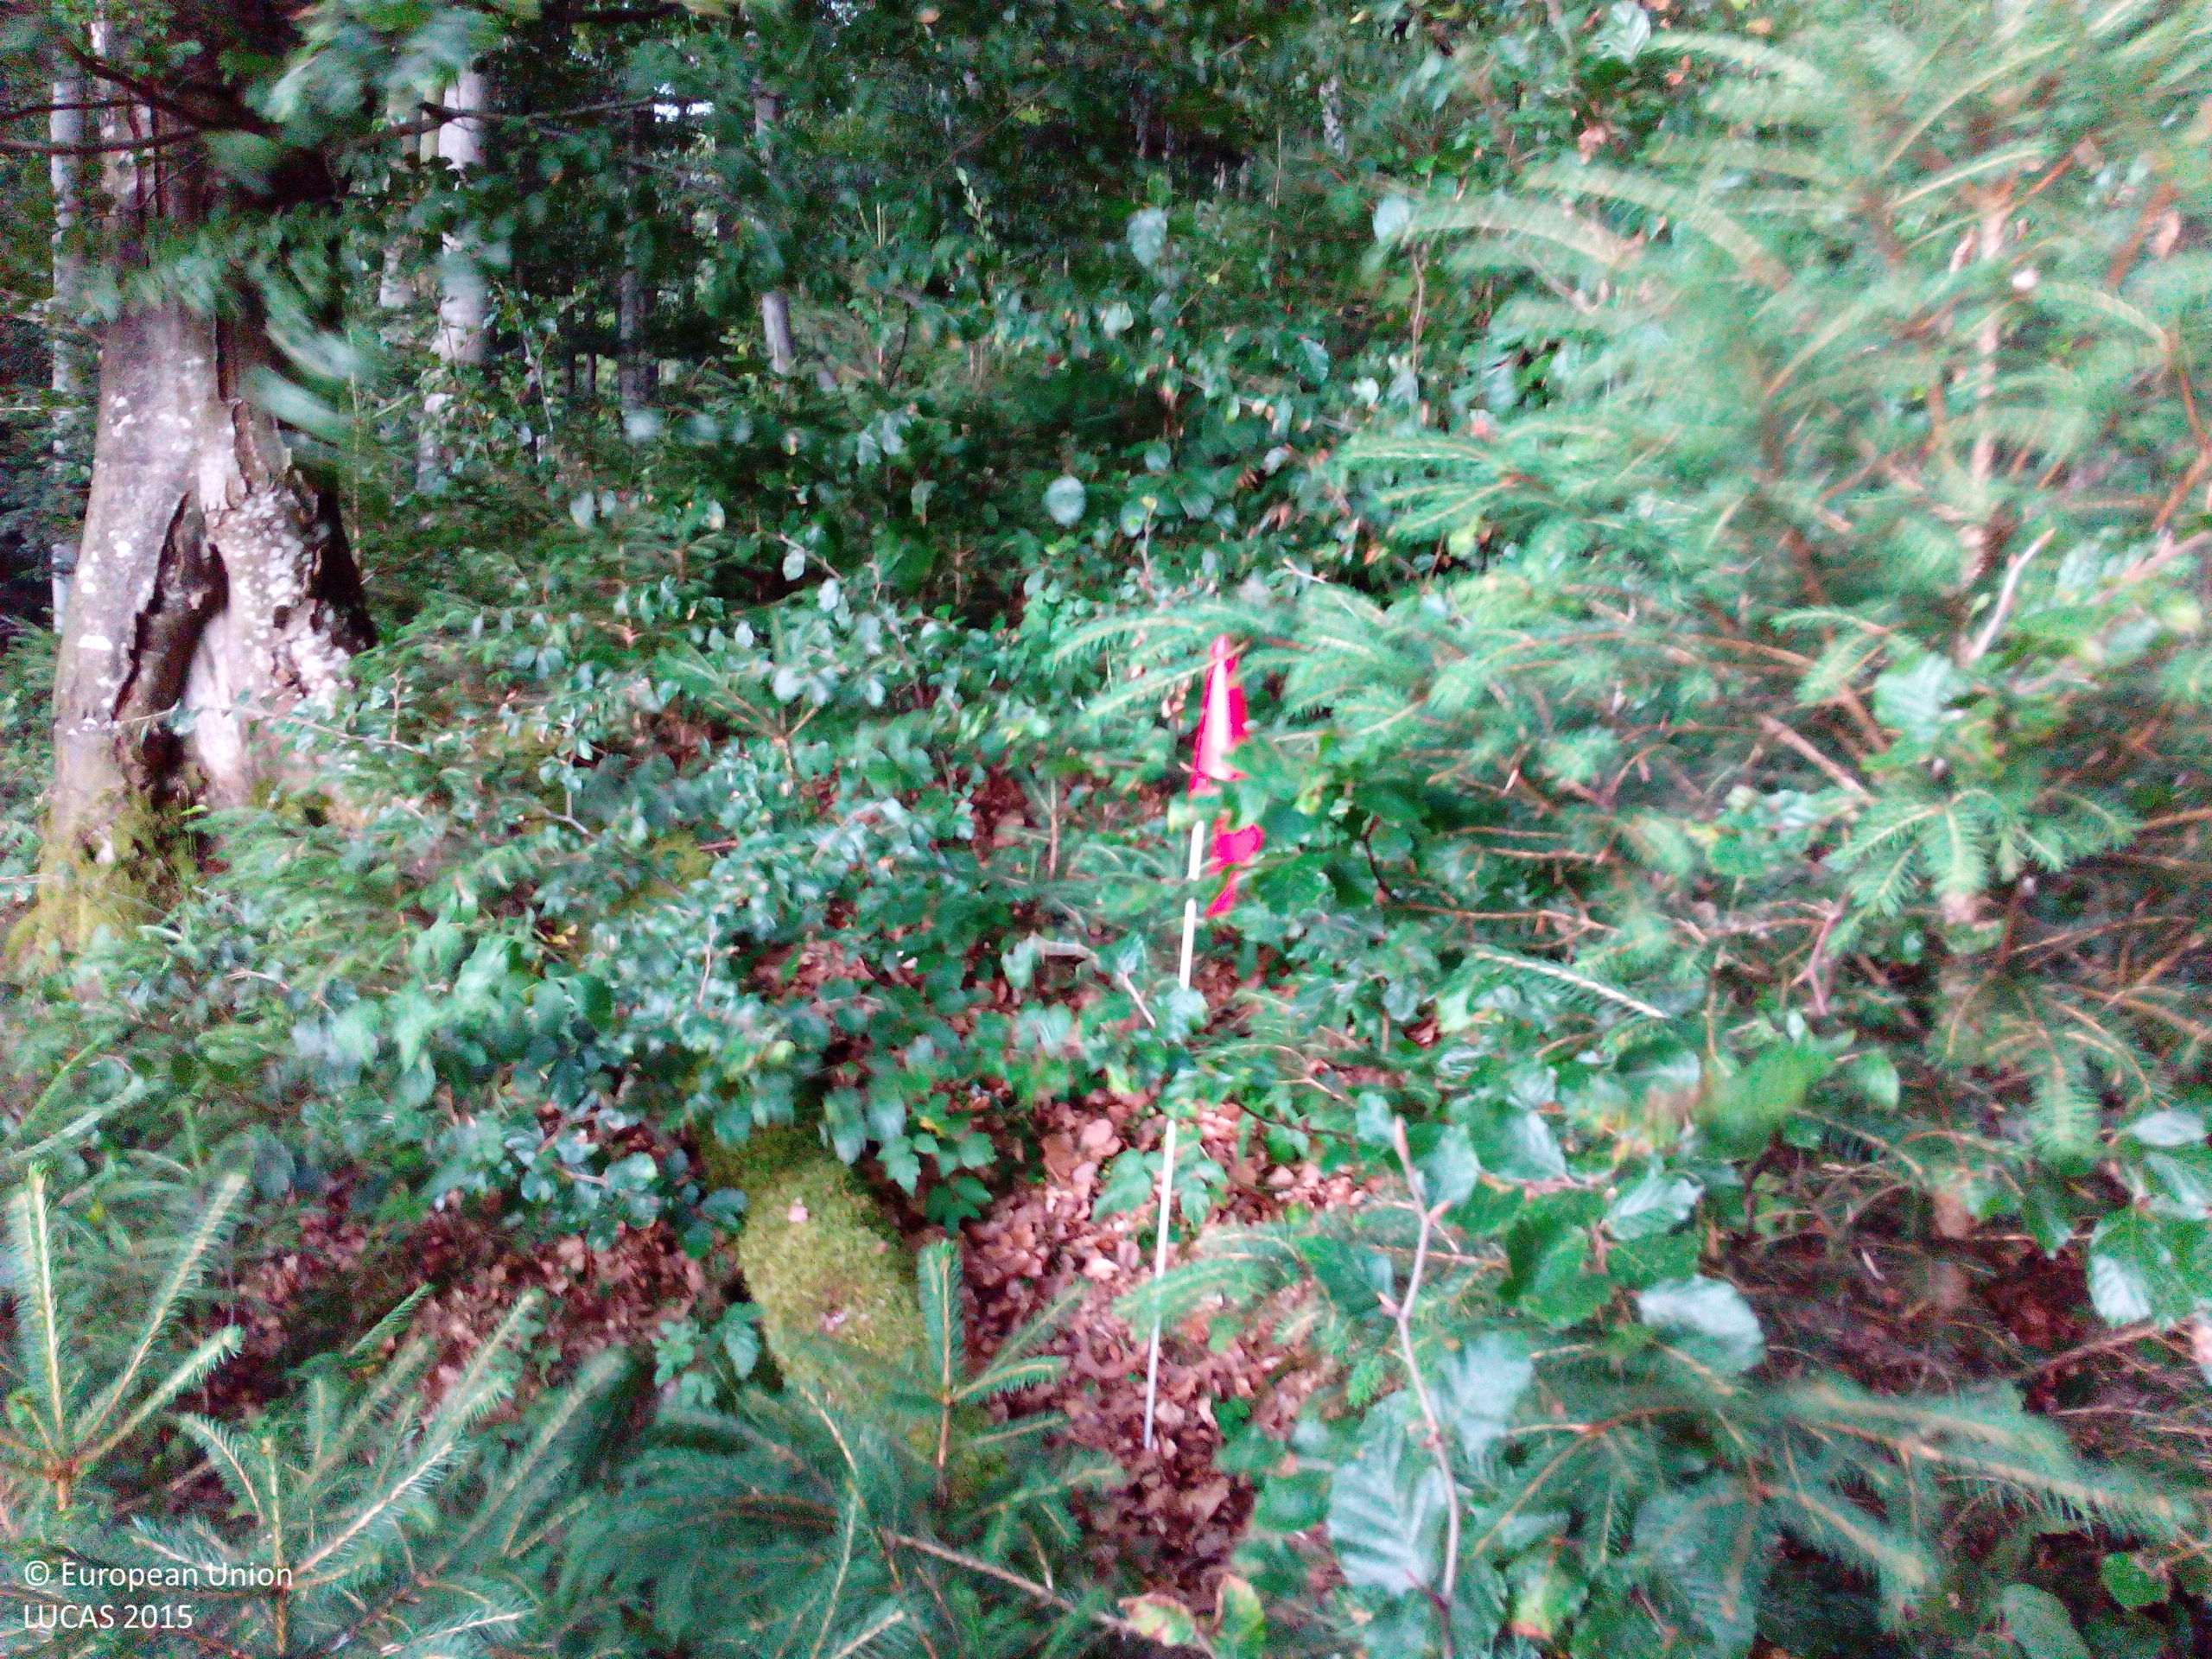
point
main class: Woodland
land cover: Spruce dominated mixed woodland
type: hemiboreal forest and nemoral coniferous forest and mixed broadleaved-coniferous forest
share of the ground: > 75 %
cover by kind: broadleaved forest trees 50 %, coniferous forest trees 35 %, unconsolidated bare surface 10 %, shrubs 5 %
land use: Forestry
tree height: < 5 m
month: July
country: DE
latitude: 48.1353
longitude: 8.1063
